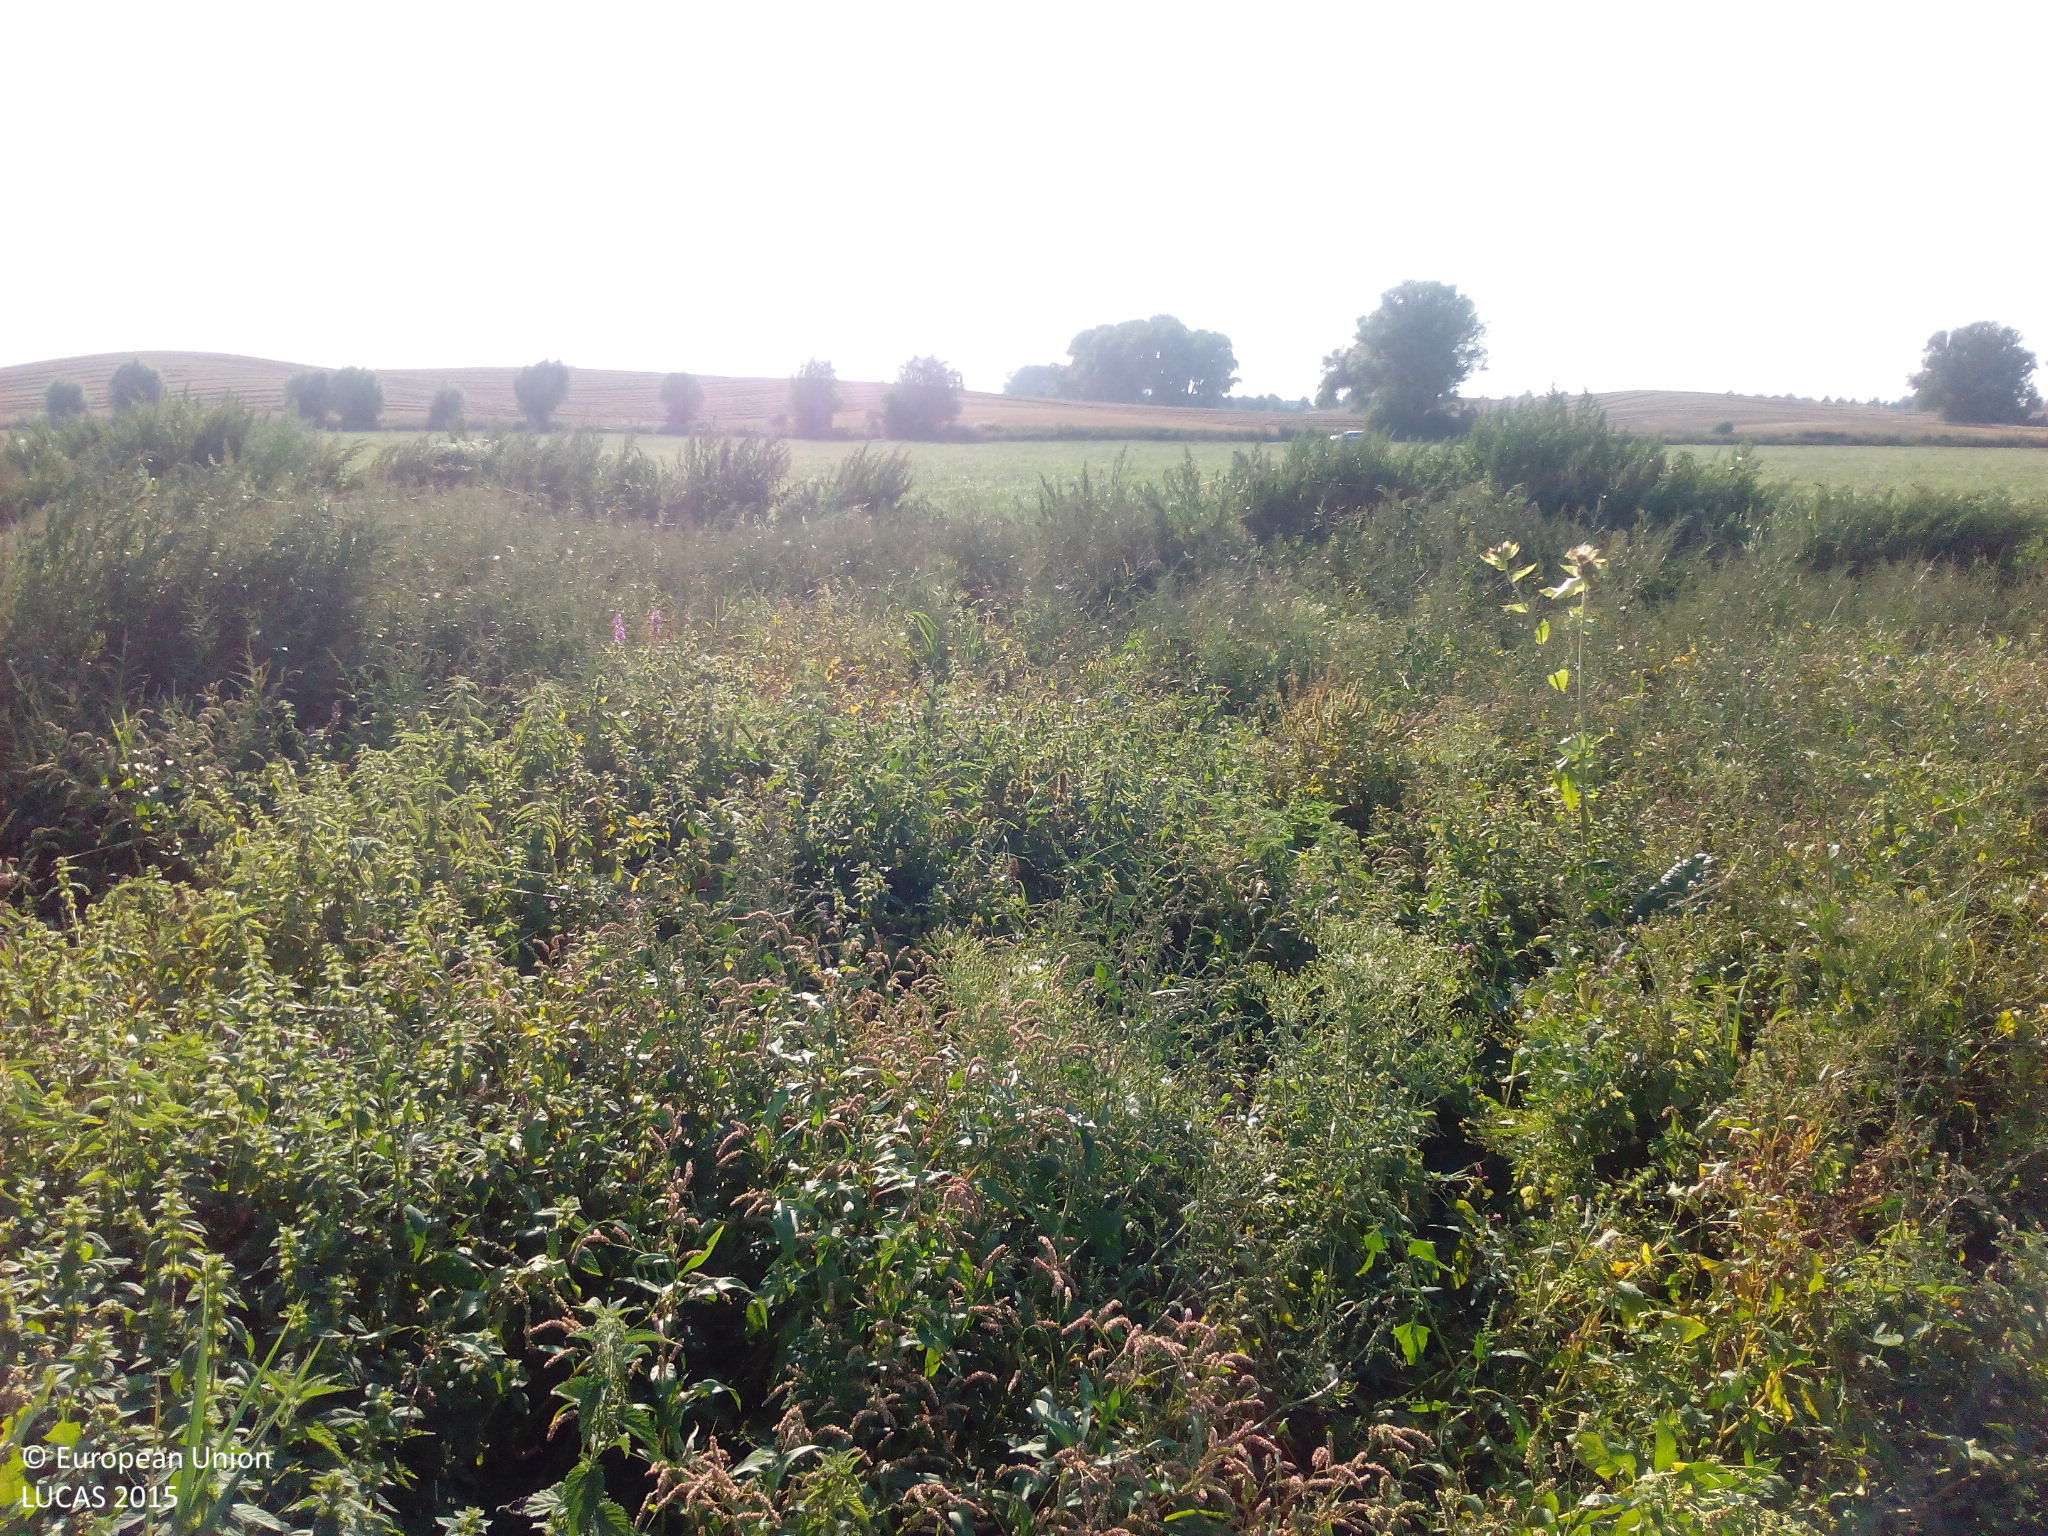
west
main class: Grassland
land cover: Spontaneously vegetated surfaces
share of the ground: > 75 %
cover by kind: herbaceous plants 100 %
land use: Semi-natural and natural areas not in use
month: August
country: DE
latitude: 53.9190
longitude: 12.3287
